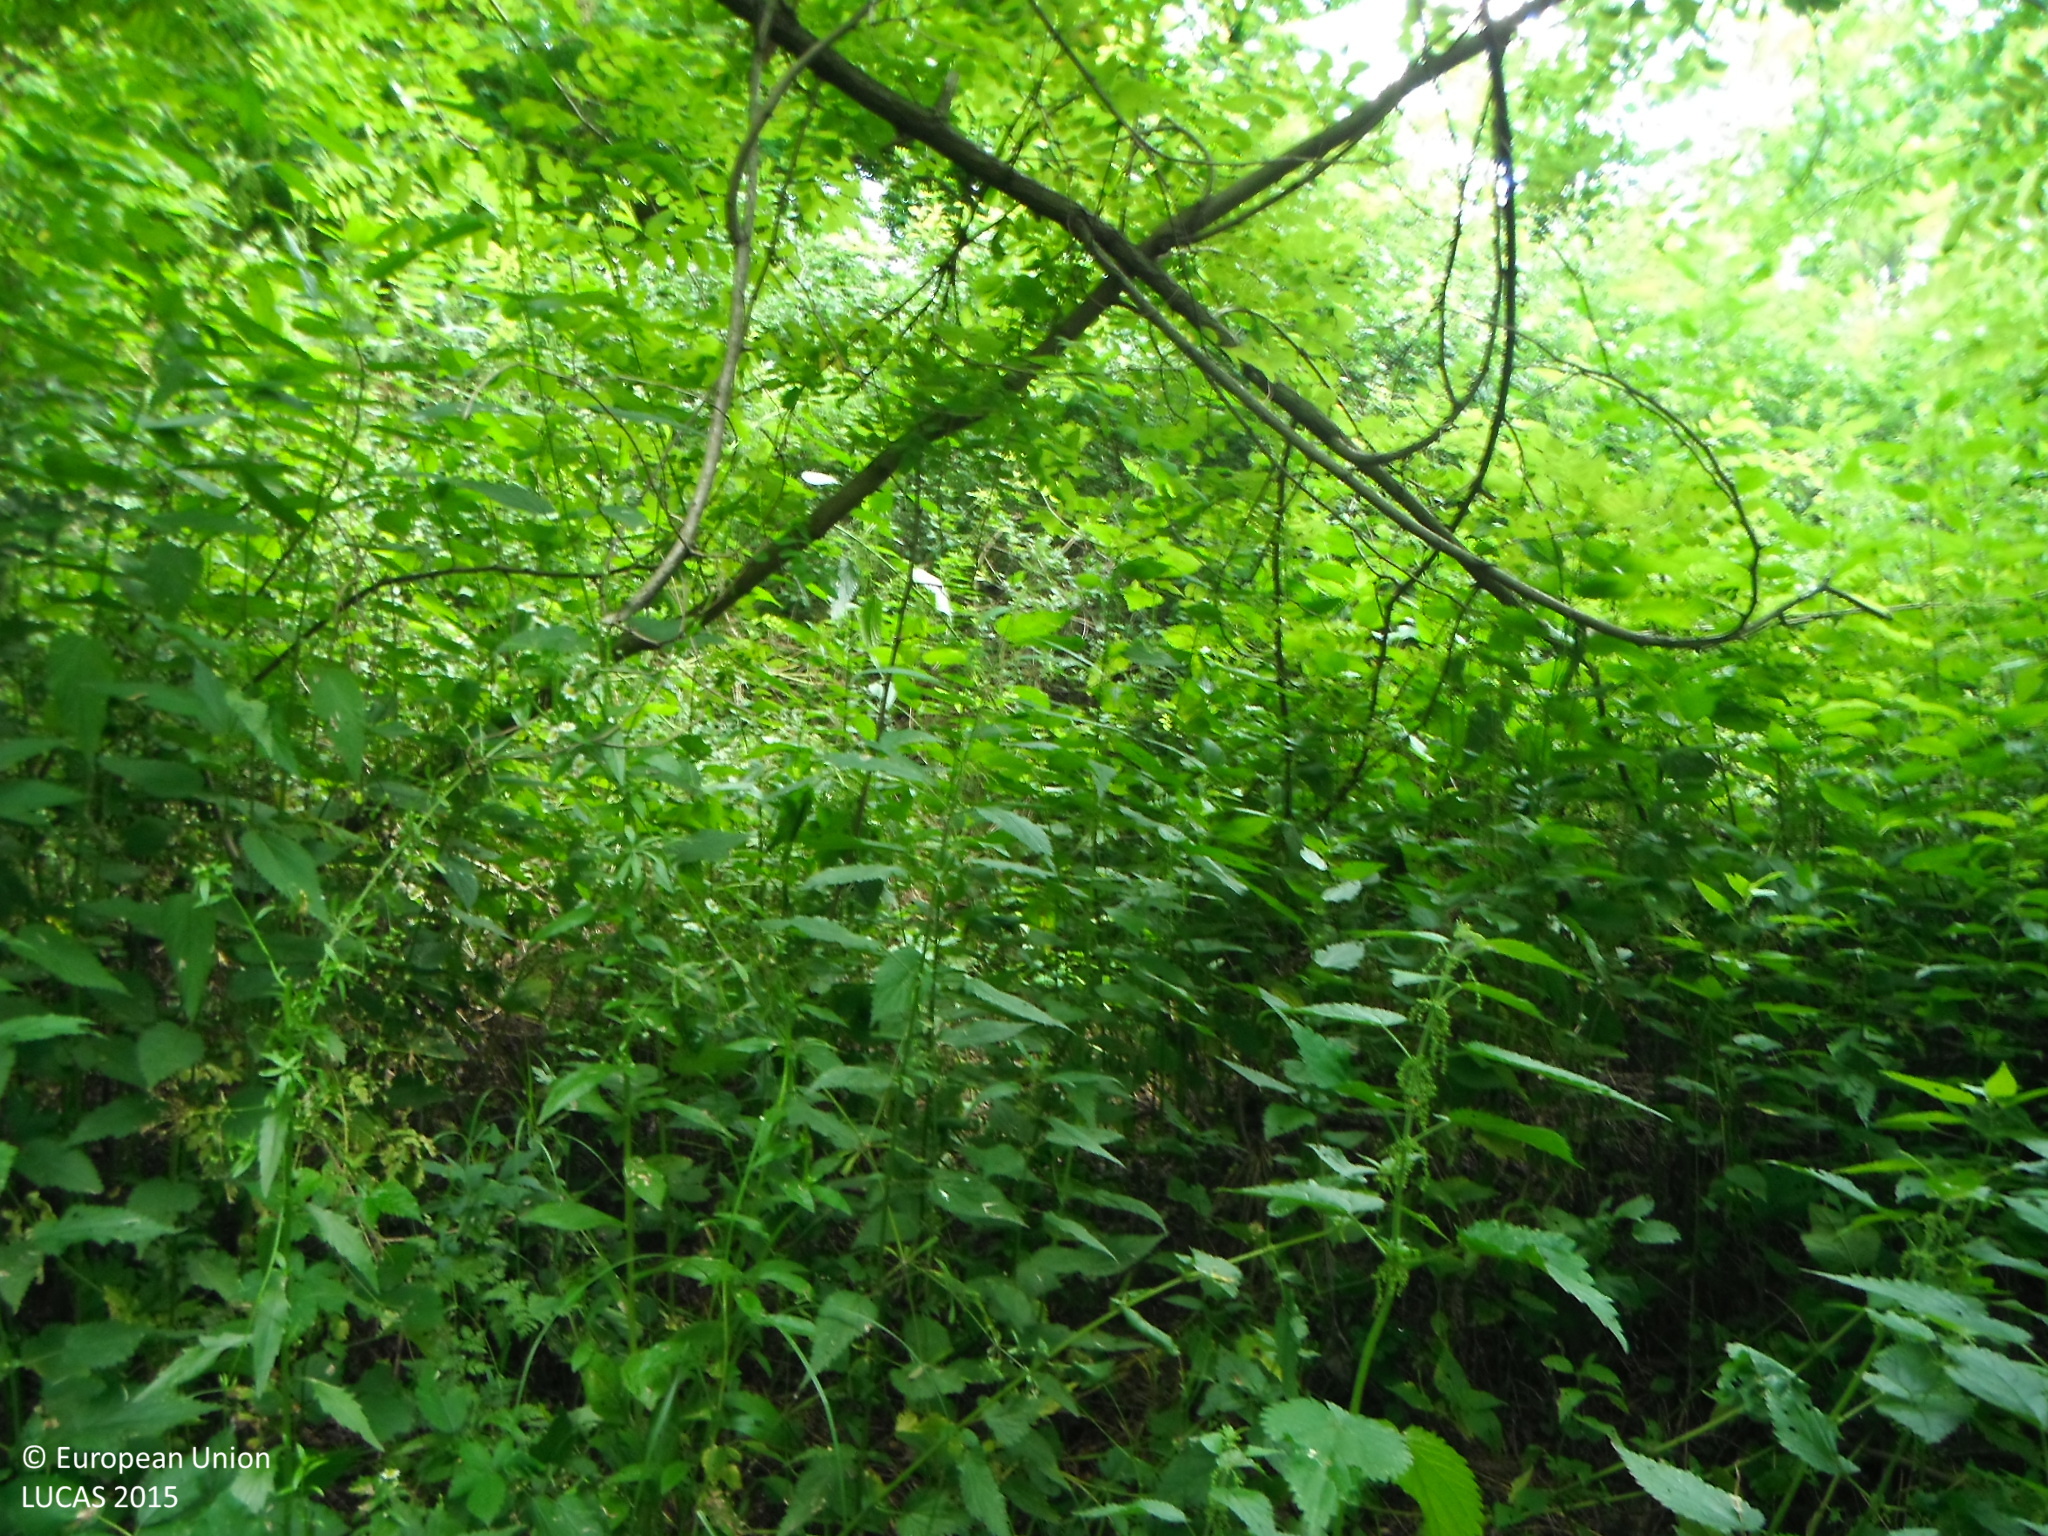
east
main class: Woodland
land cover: Broadleaved woodland
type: mesophytic deciduous forest
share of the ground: > 75 %
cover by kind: broadleaved forest trees 100 %
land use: Forestry
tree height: > 5 m
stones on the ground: < 10 %
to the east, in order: Broadleaved woodland; Shrubland with sparse tree cover; Grassland with sparse tree/shrub cover; Tracks; Broadleaved woodland
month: July
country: SK
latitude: 48.6505
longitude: 20.0617
